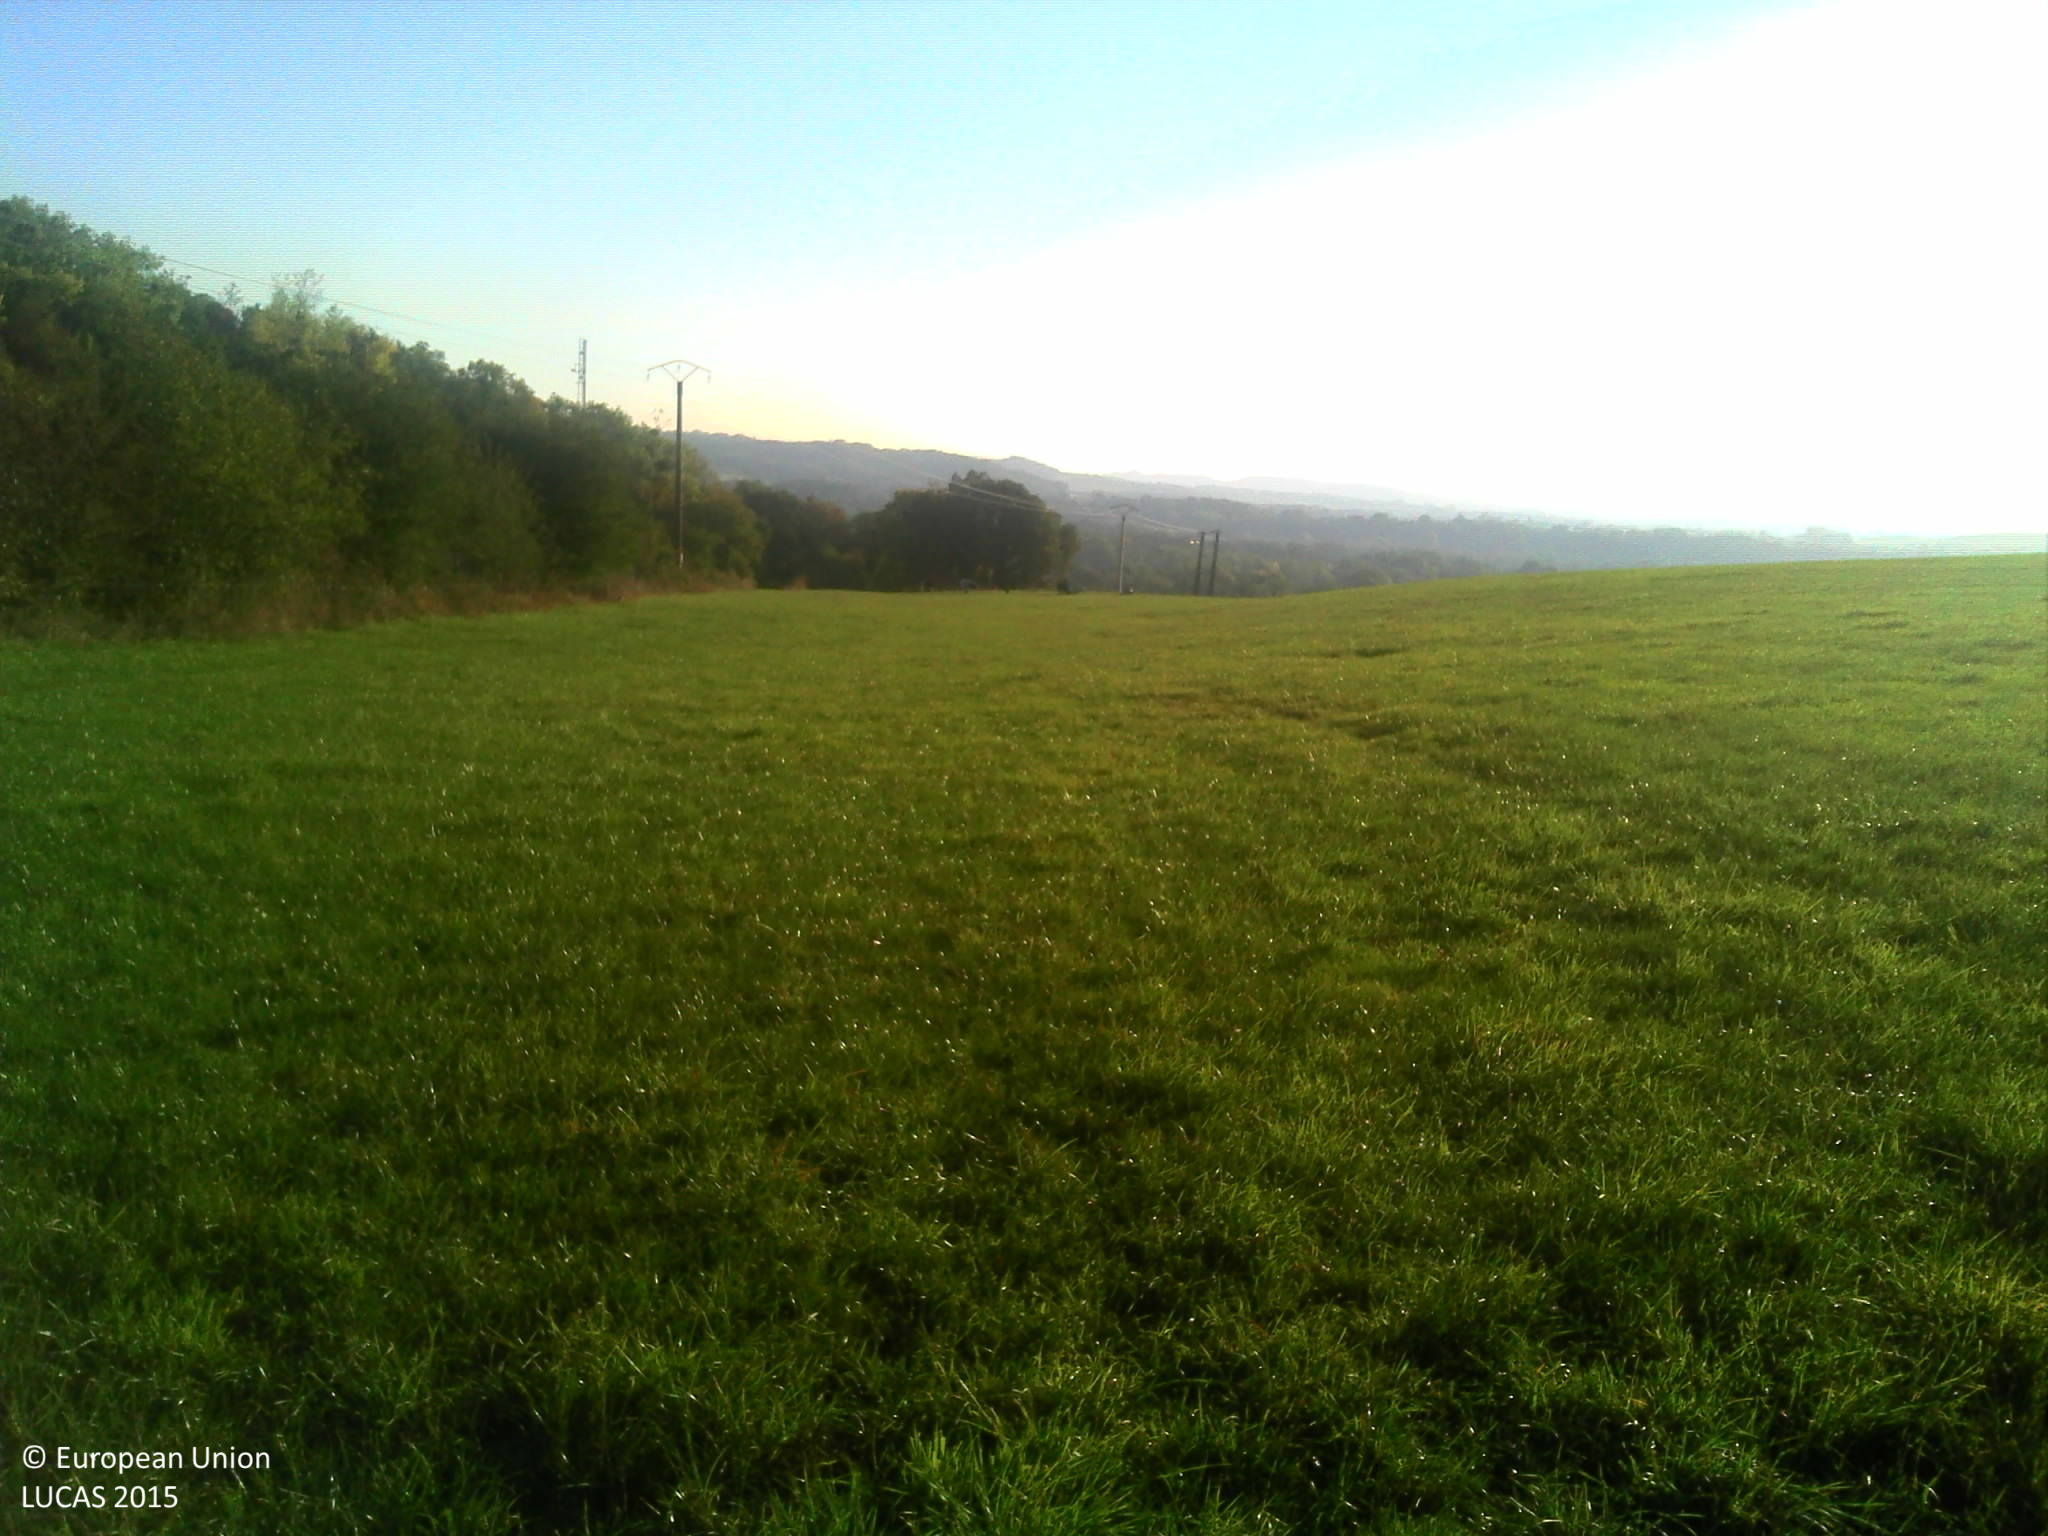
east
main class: Grassland
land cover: Grassland without tree/shrub cover
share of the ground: > 75 %
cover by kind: herbaceous plants 95 %, consolidated bare surface 5 %
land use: Agriculture (excluding fallow land and kitchen gardens)
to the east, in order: Grassland without tree/shrub cover; Fences; Grass margins; Tracks; Grass margins; Fences; Ditches and canals; Temporary grasslands
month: October
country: FR
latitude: 48.4671
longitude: 6.2809
